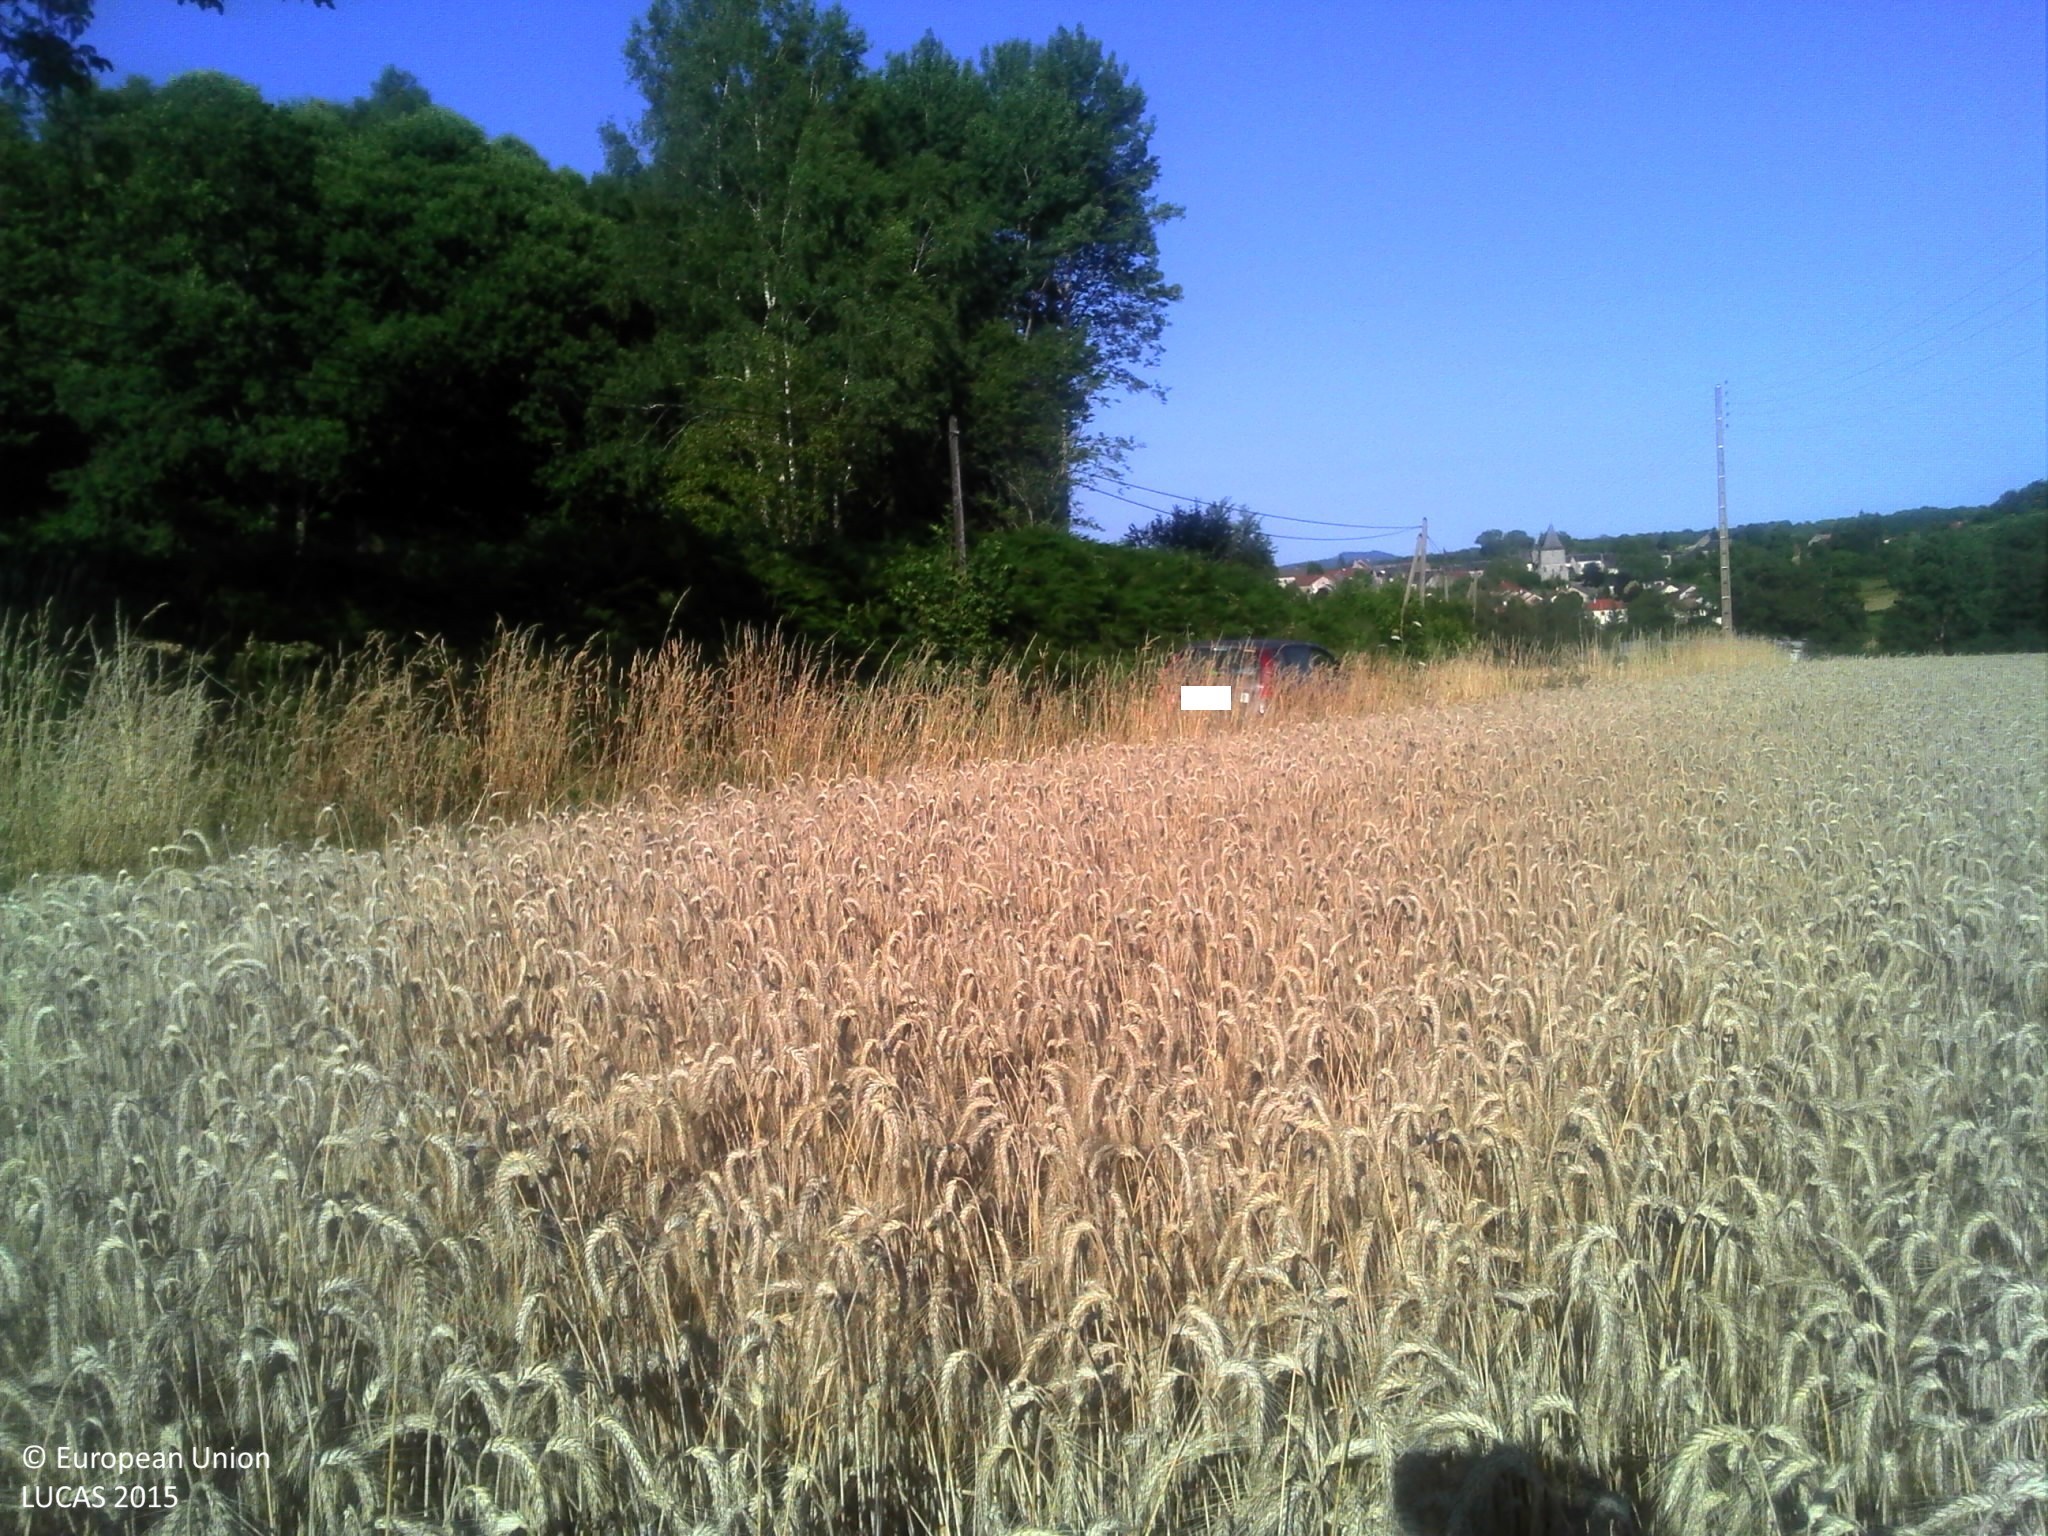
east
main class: Cropland
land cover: Common wheat
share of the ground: > 75 %
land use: Agriculture (excluding fallow land and kitchen gardens)
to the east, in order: Common wheat; Ditches and canals; Grass margins; Paved roads, cycling and walking lanes; Ditches and canals; Electric lines; Spontaneously vegetated surfaces; Broadleaved woodland; Tracks; Grassland with sparse tree/shrub cover; Grassland without tree/shrub cover; Paved roads, cycling and walking lanes; Grass margins; Managed hedges; Fences; Grassland without tree/shrub cover
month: July
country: FR
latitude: 46.2357
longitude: 1.5752
